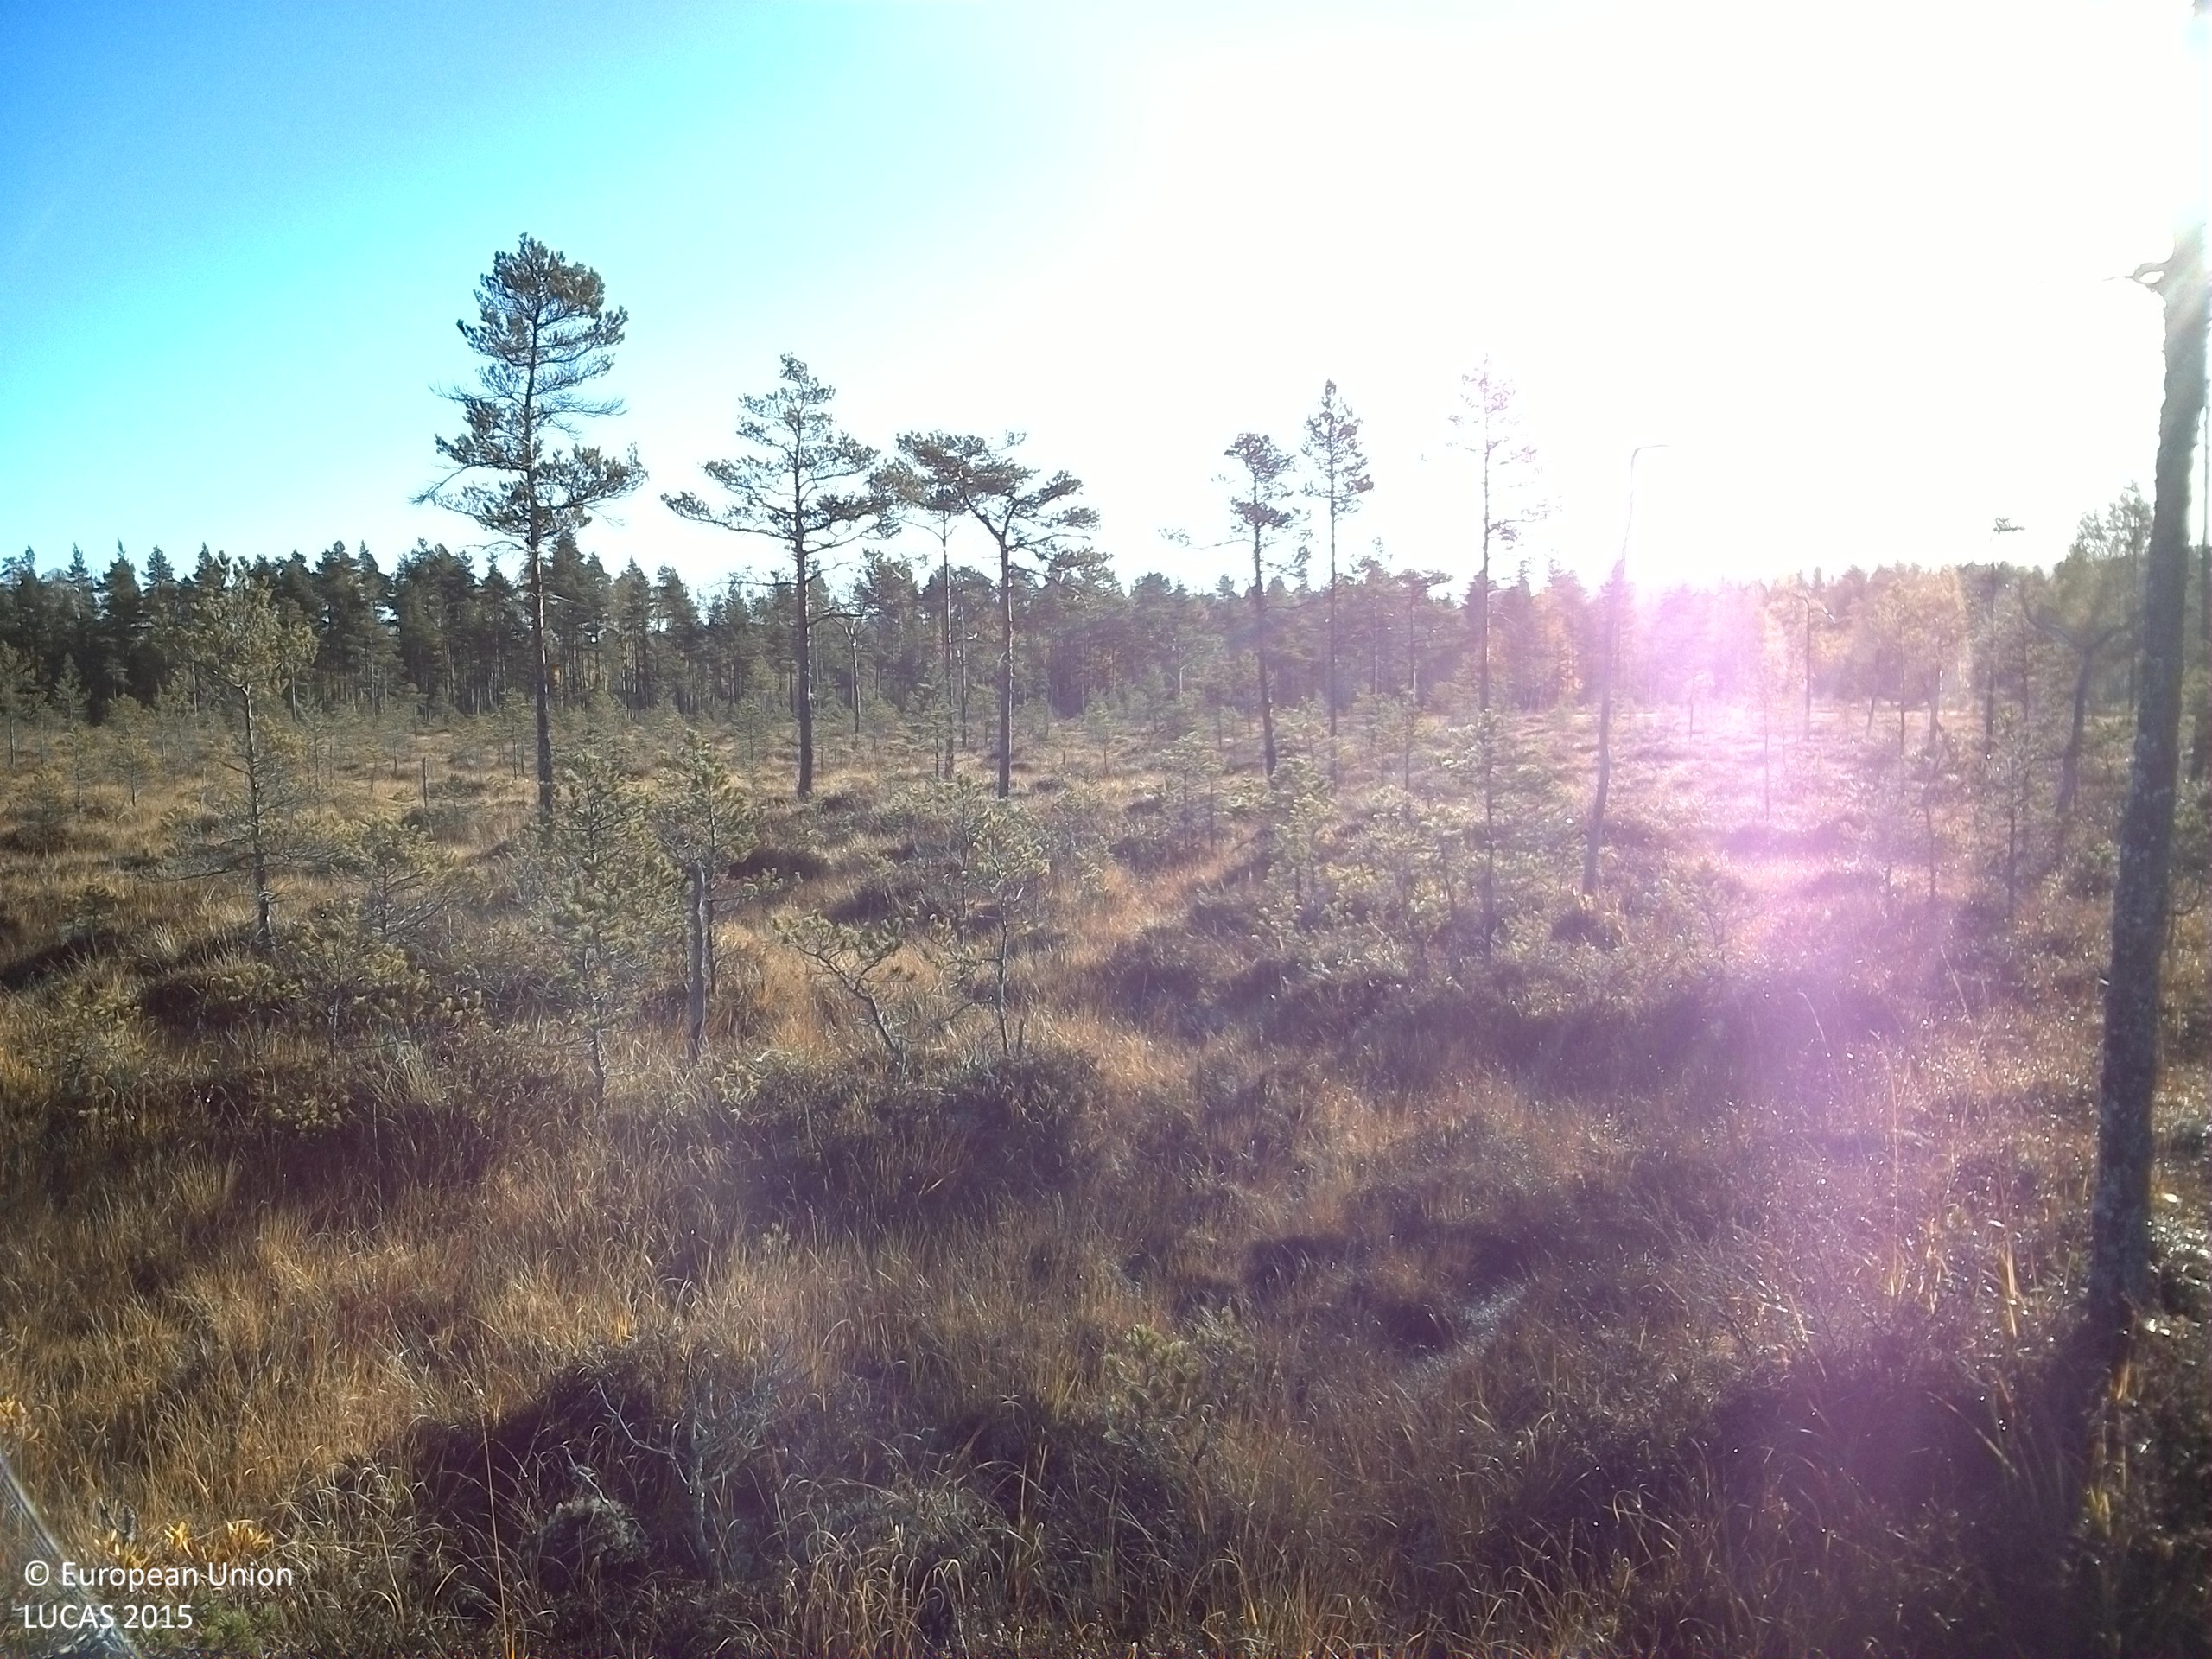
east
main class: Woodland
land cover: Pine dominated coniferous woodland
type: boreal forest
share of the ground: 10 - 25 %
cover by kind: shrubs 40 %, coniferous forest trees 20 %, herbaceous plants 20 %, lichens and mosses 20 %
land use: Forestry
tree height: < 5 m
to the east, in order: Pine dominated coniferous woodland; Ditches and canals; Pine dominated mixed woodland; Shrubland without tree cover; Paved roads, cycling and walking lanes; Pine dominated mixed woodland; Rivers and streams; Pine dominated mixed woodland
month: October
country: SE
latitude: 61.1994
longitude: 15.3256
